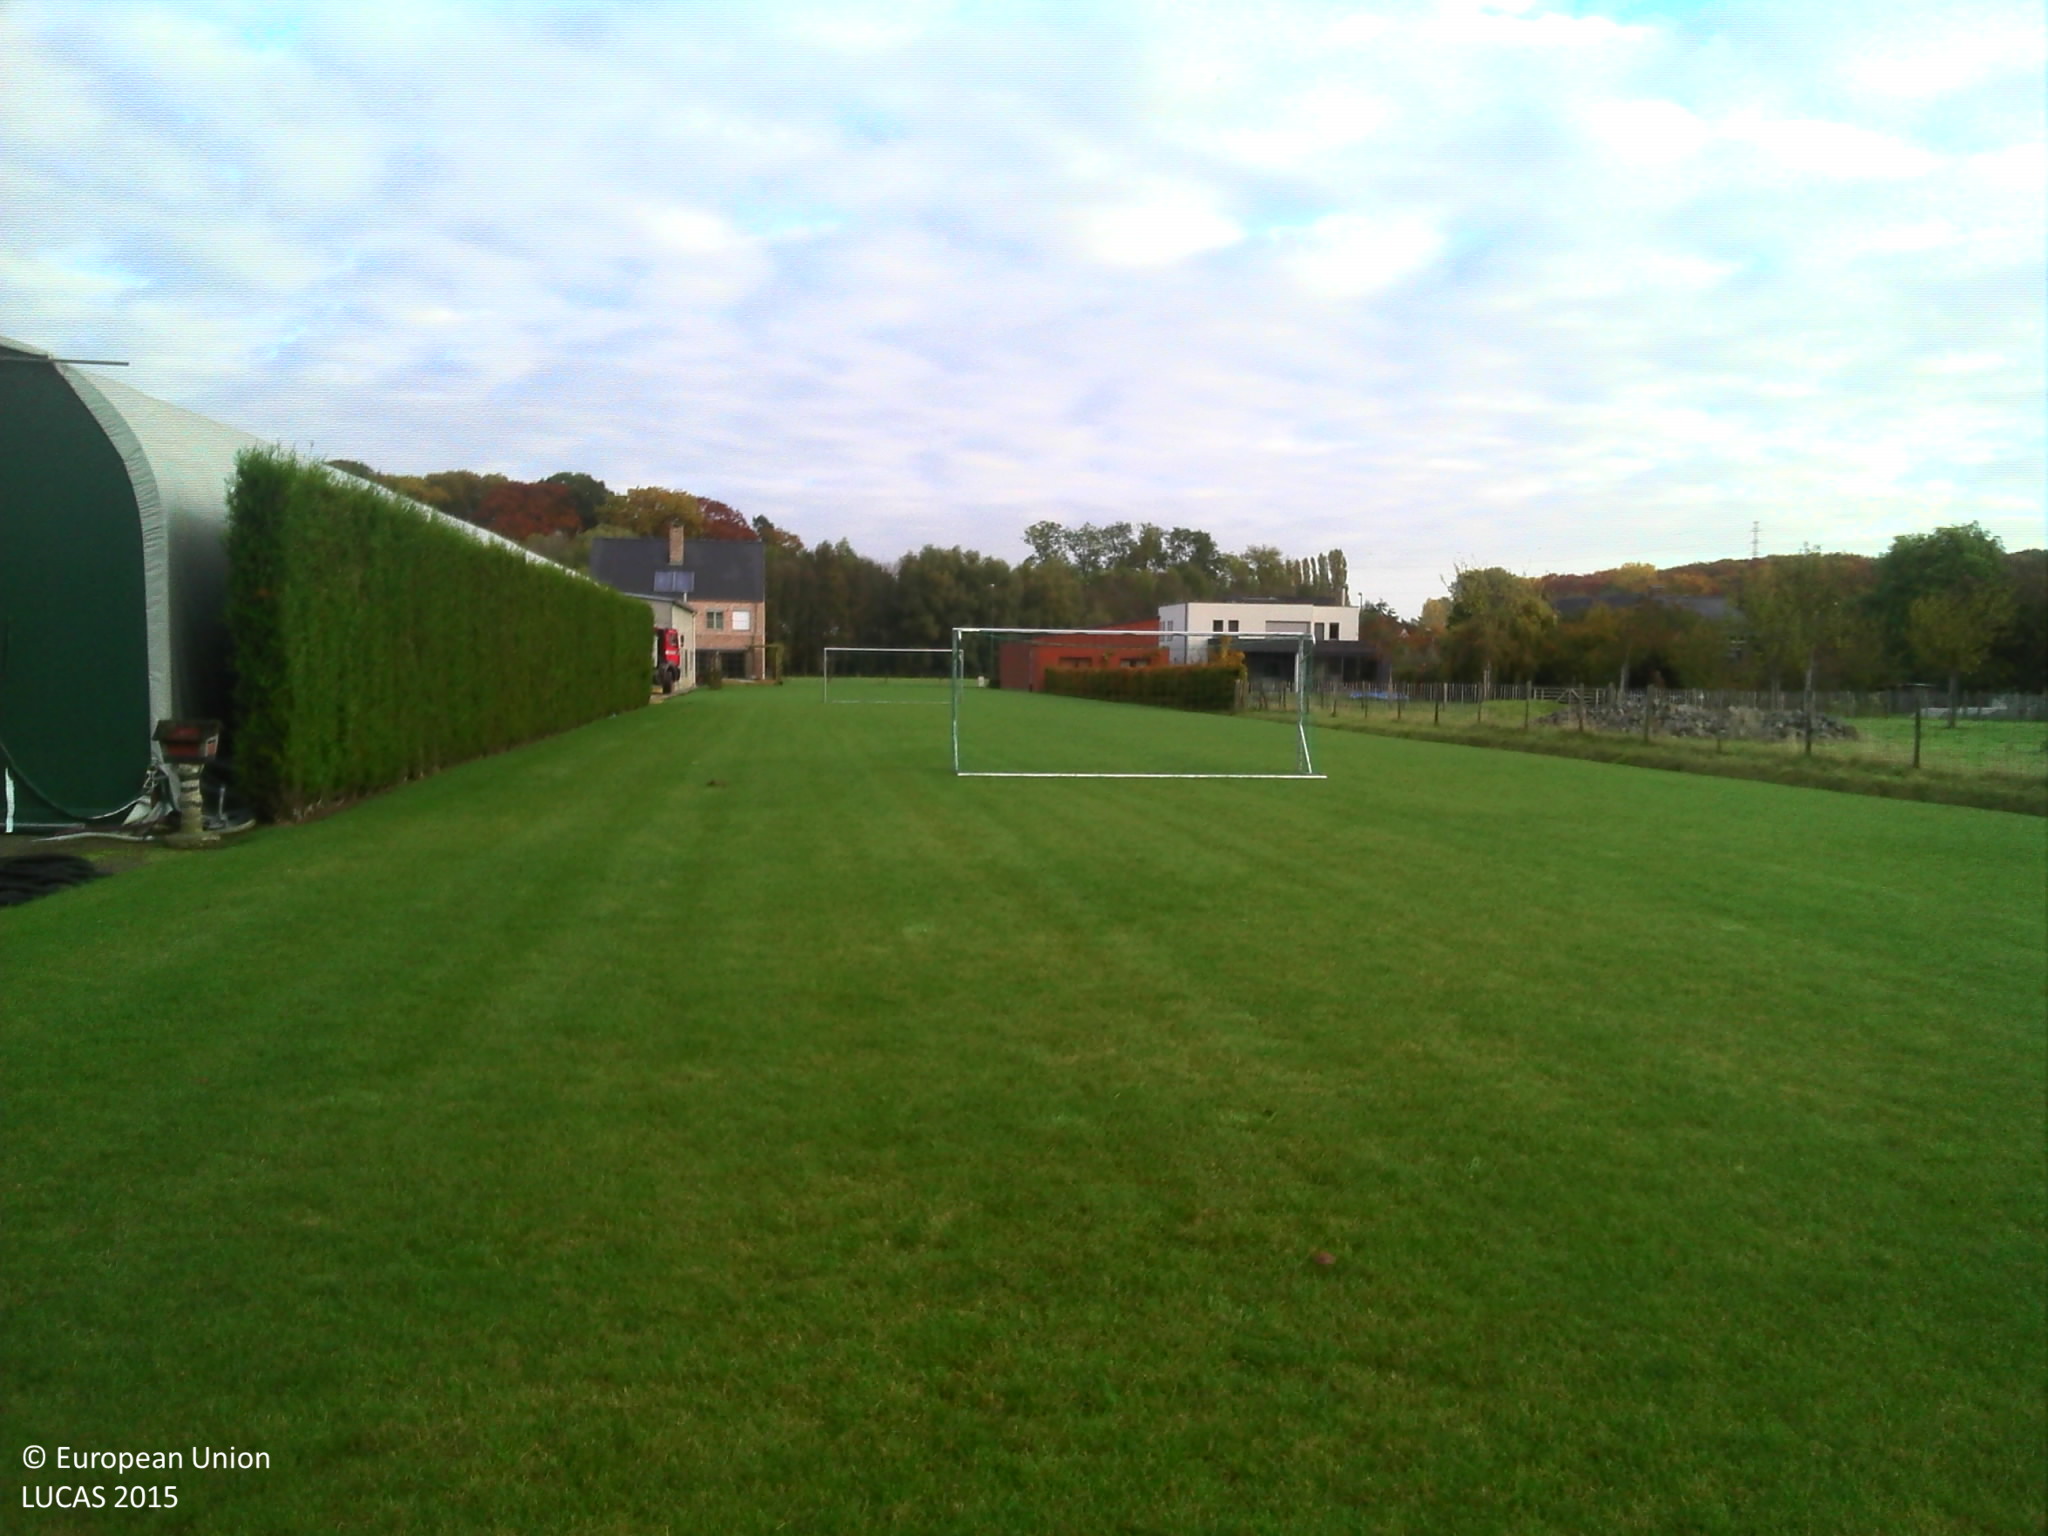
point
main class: Grassland
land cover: Grassland without tree/shrub cover
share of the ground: > 75 %
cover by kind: herbaceous plants 100 %
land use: Residential
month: October
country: BE
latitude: 50.9561
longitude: 4.5720
